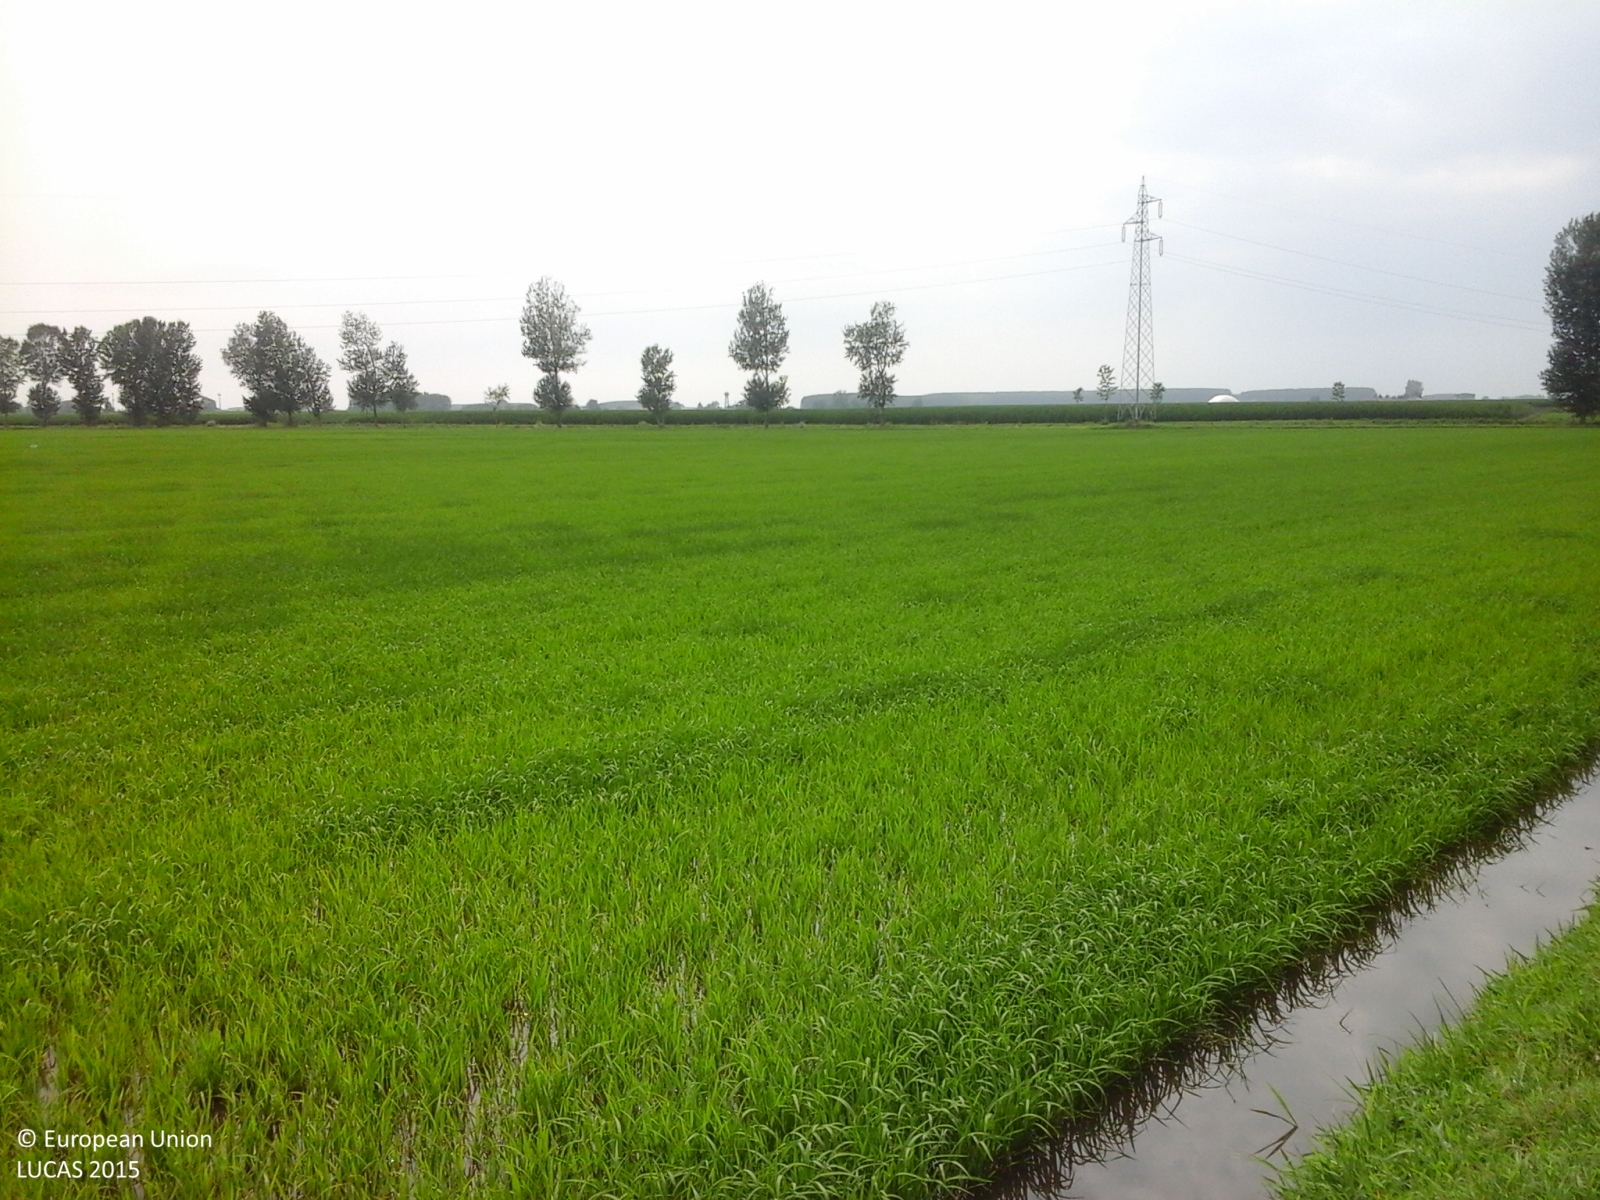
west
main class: Cropland
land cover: Rice
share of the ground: 50 - 75 %
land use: Agriculture (excluding fallow land and kitchen gardens)
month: June
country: IT
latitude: 45.3143
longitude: 8.5611
